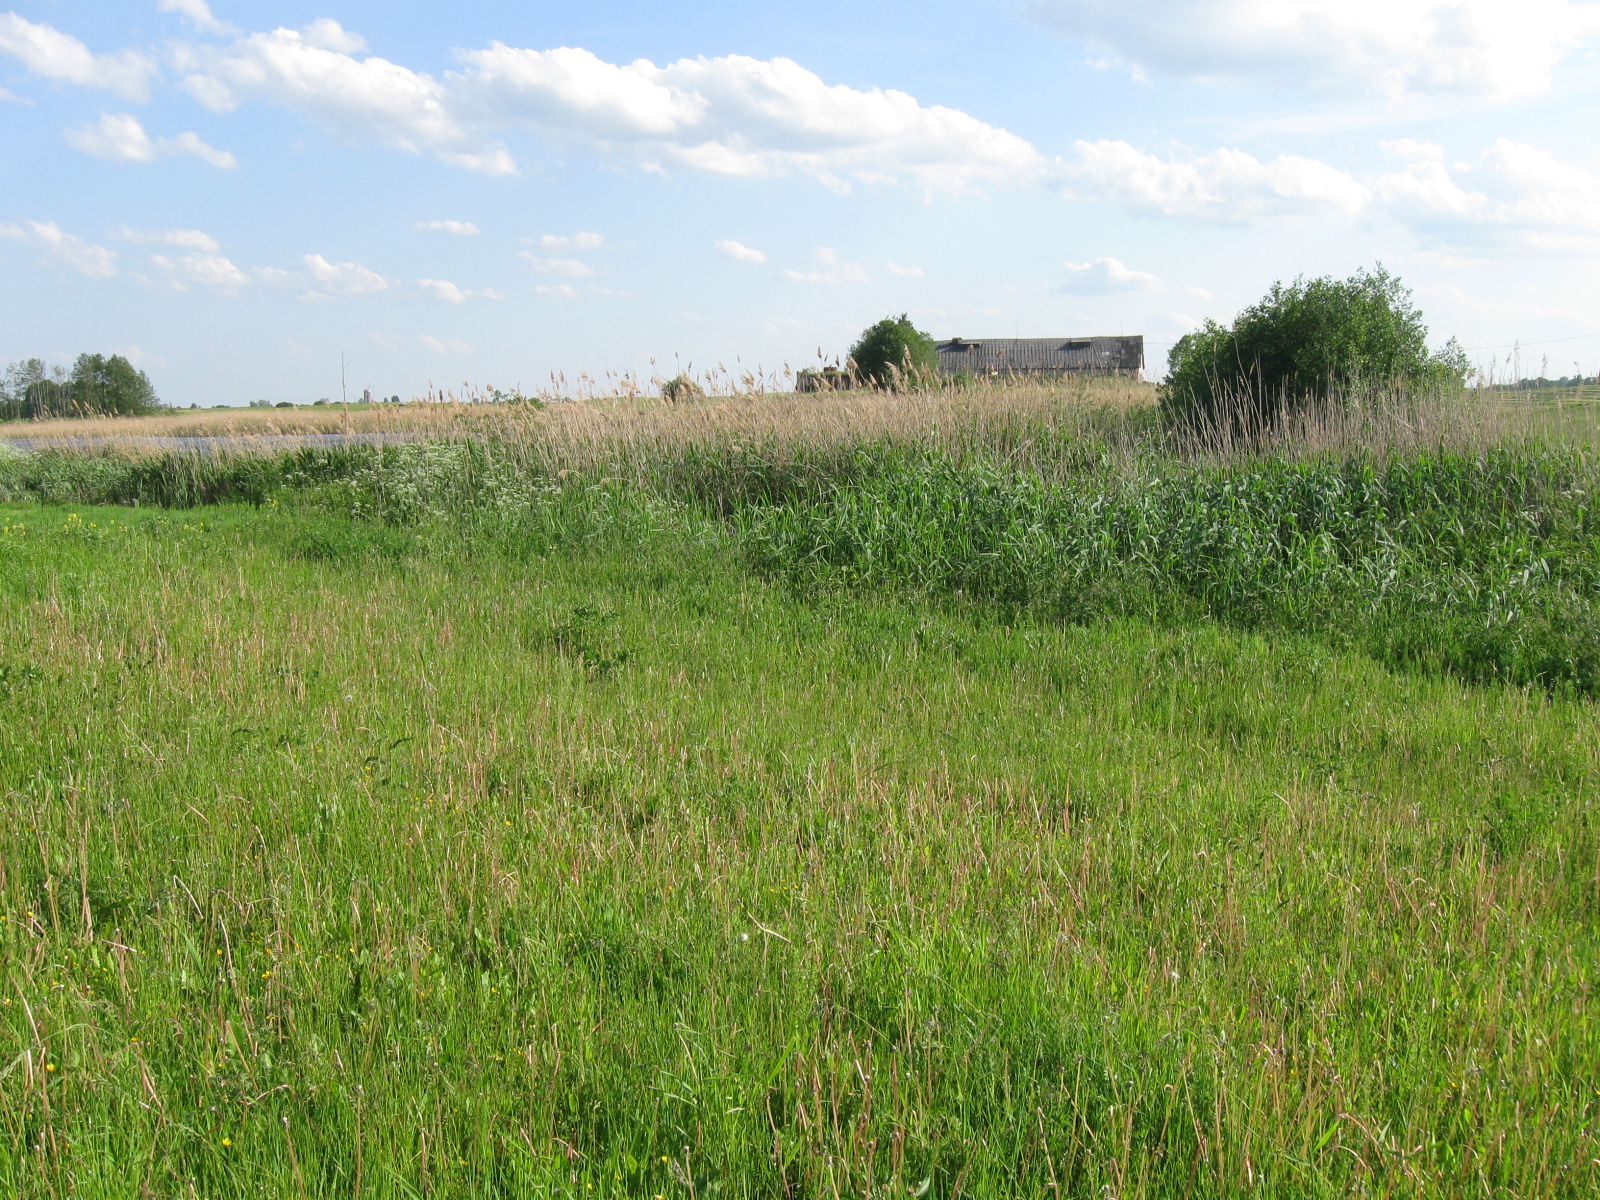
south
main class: Grassland
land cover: Grassland without tree/shrub cover
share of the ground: > 75 %
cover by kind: herbaceous plants 100 %
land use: Agriculture (excluding fallow land and kitchen gardens)
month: June
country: LT
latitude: 54.2398
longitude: 23.7278
